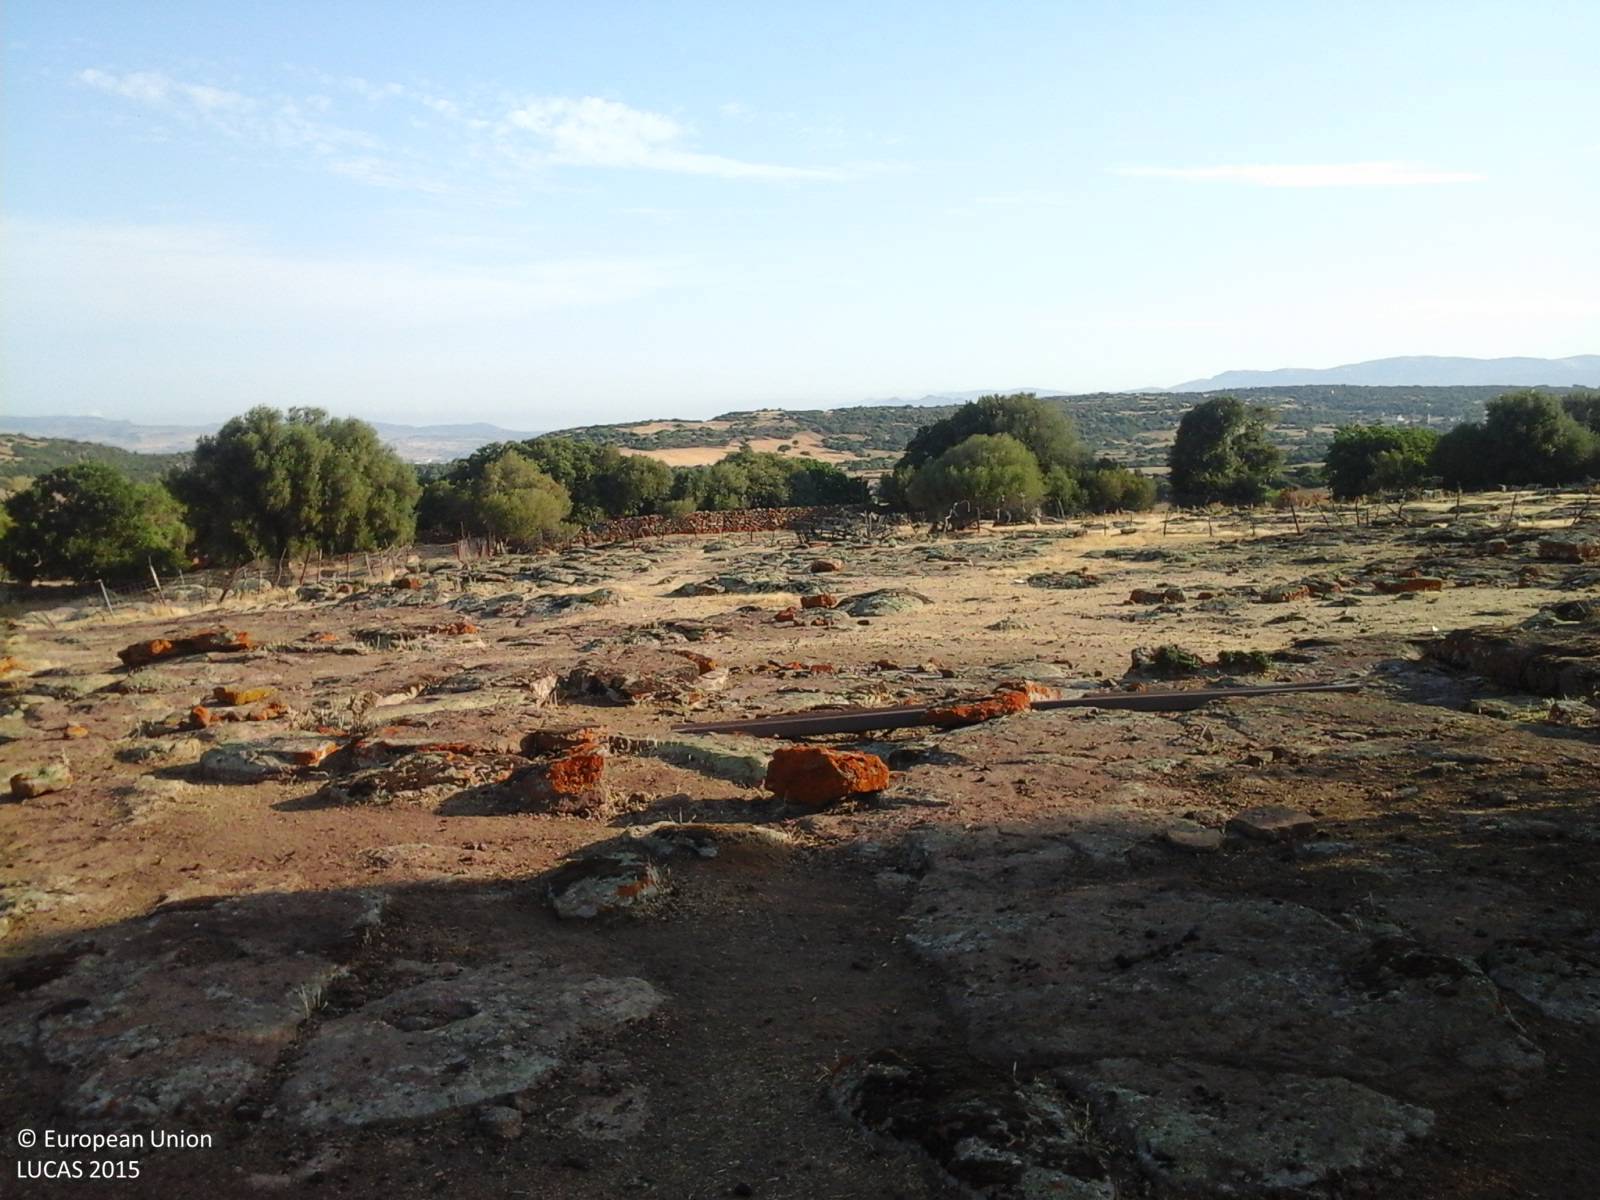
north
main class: Grassland
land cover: Grassland without tree/shrub cover
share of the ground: < 10 %
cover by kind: consolidated bare surface 80 %, herbaceous plants 20 %
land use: Agriculture (excluding fallow land and kitchen gardens)
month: July
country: IT
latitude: 40.7499
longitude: 8.9038
